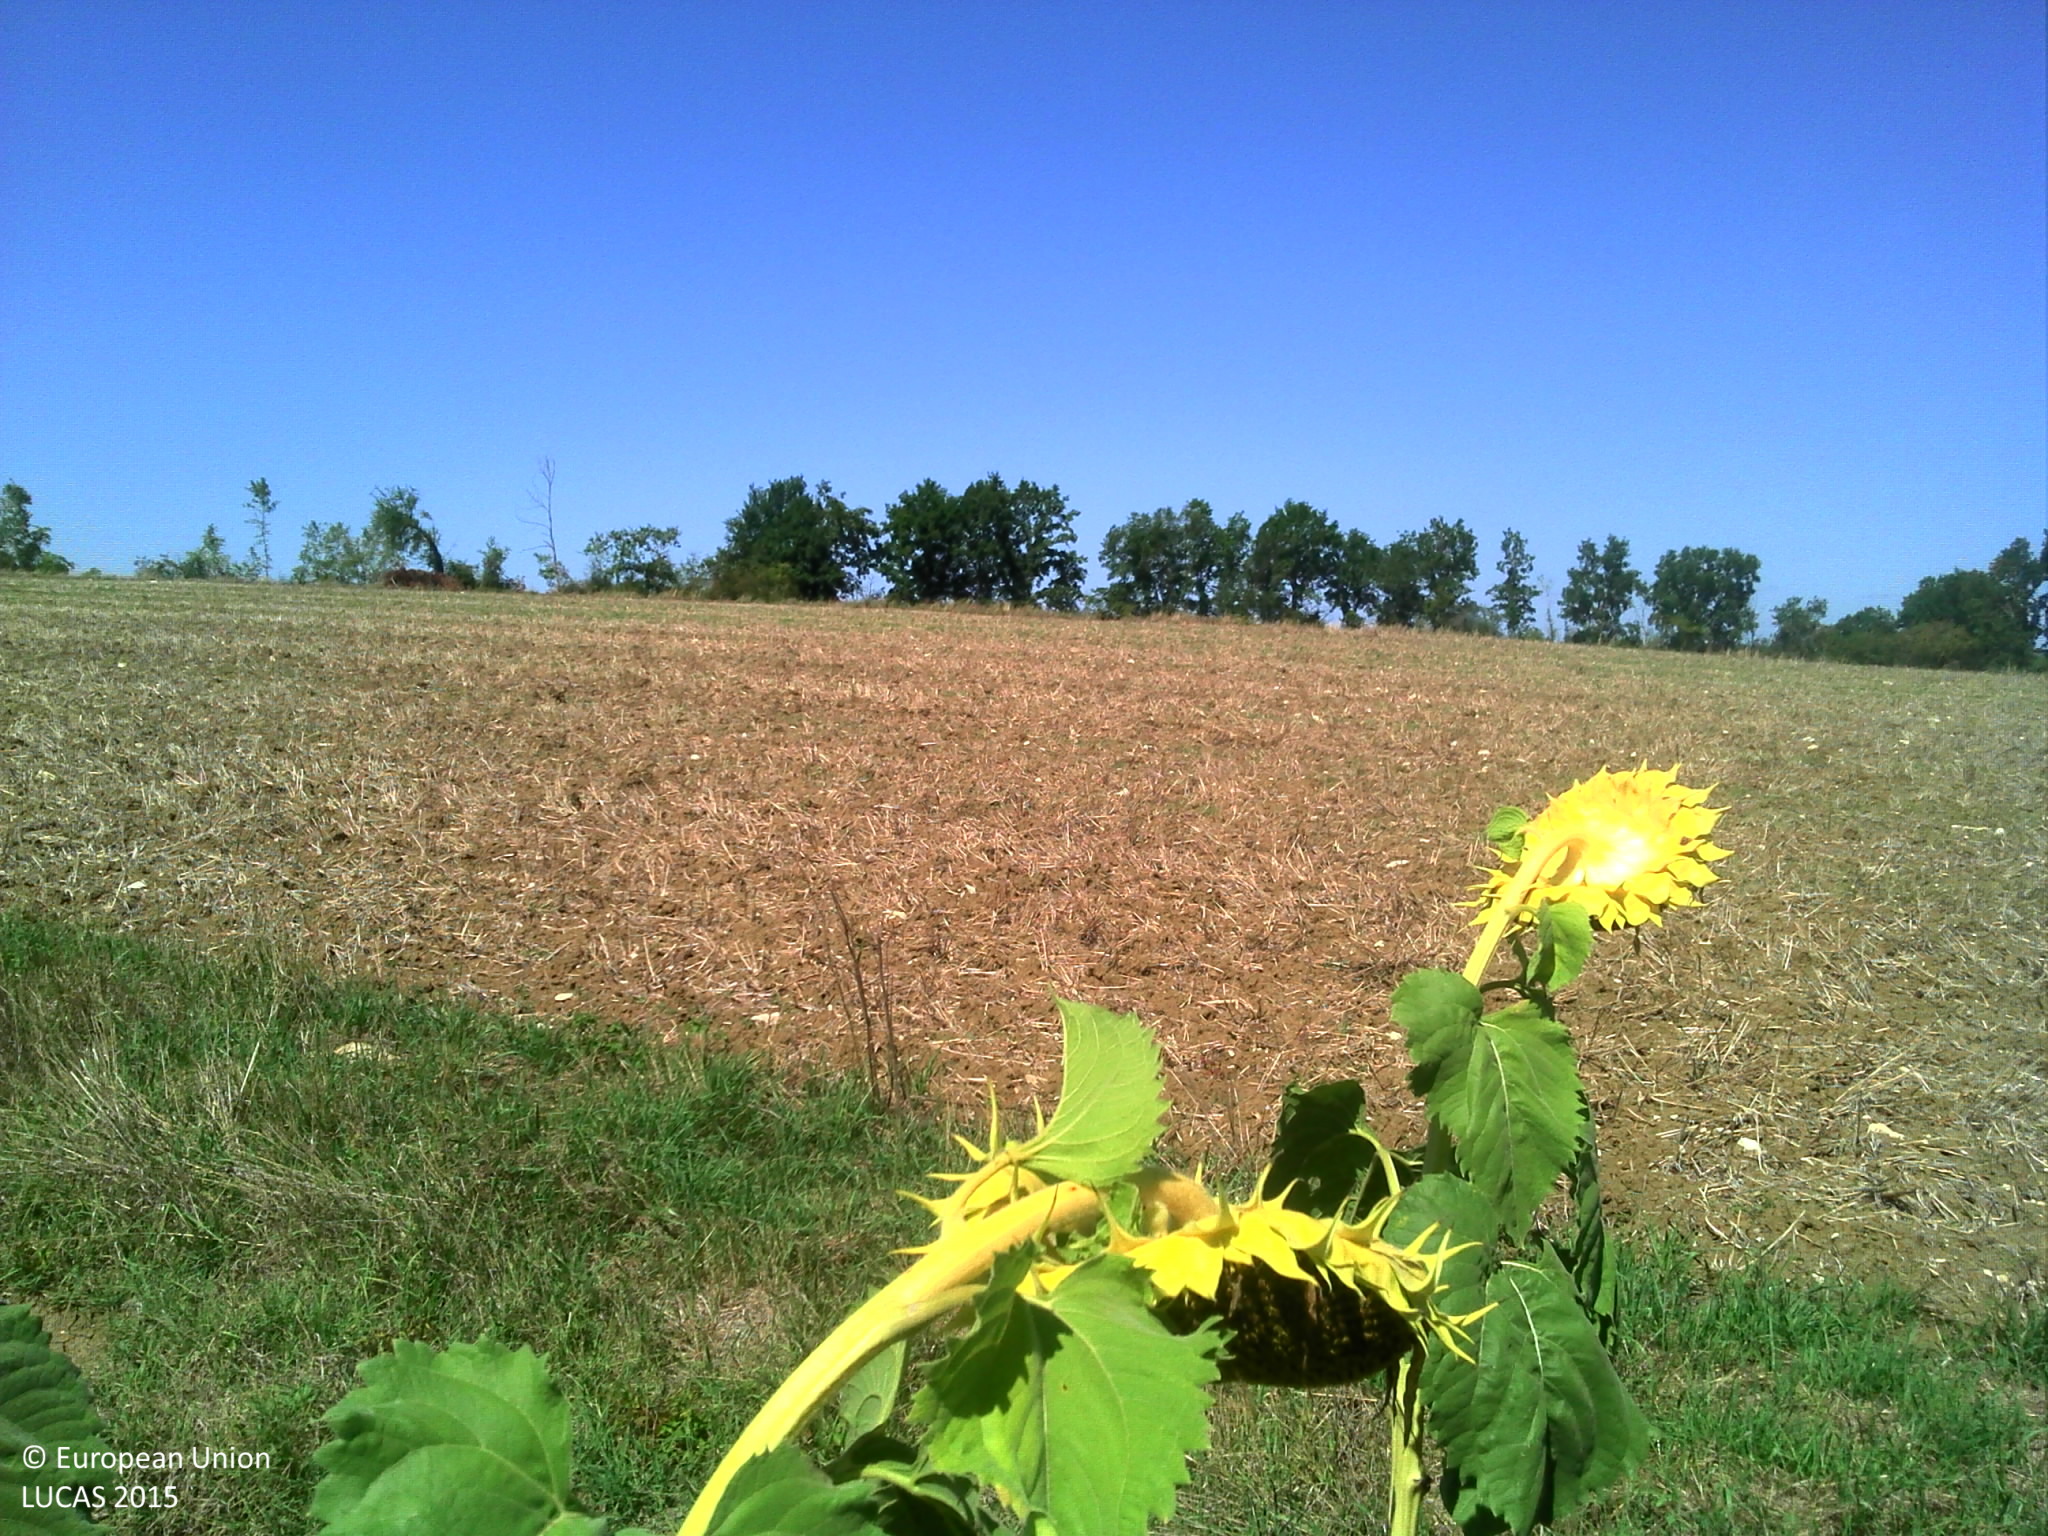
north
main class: Cropland
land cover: Sunflower
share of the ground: > 75 %
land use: Agriculture (excluding fallow land and kitchen gardens)
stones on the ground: < 10 %
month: August
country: FR
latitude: 44.2905
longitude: 1.4898
